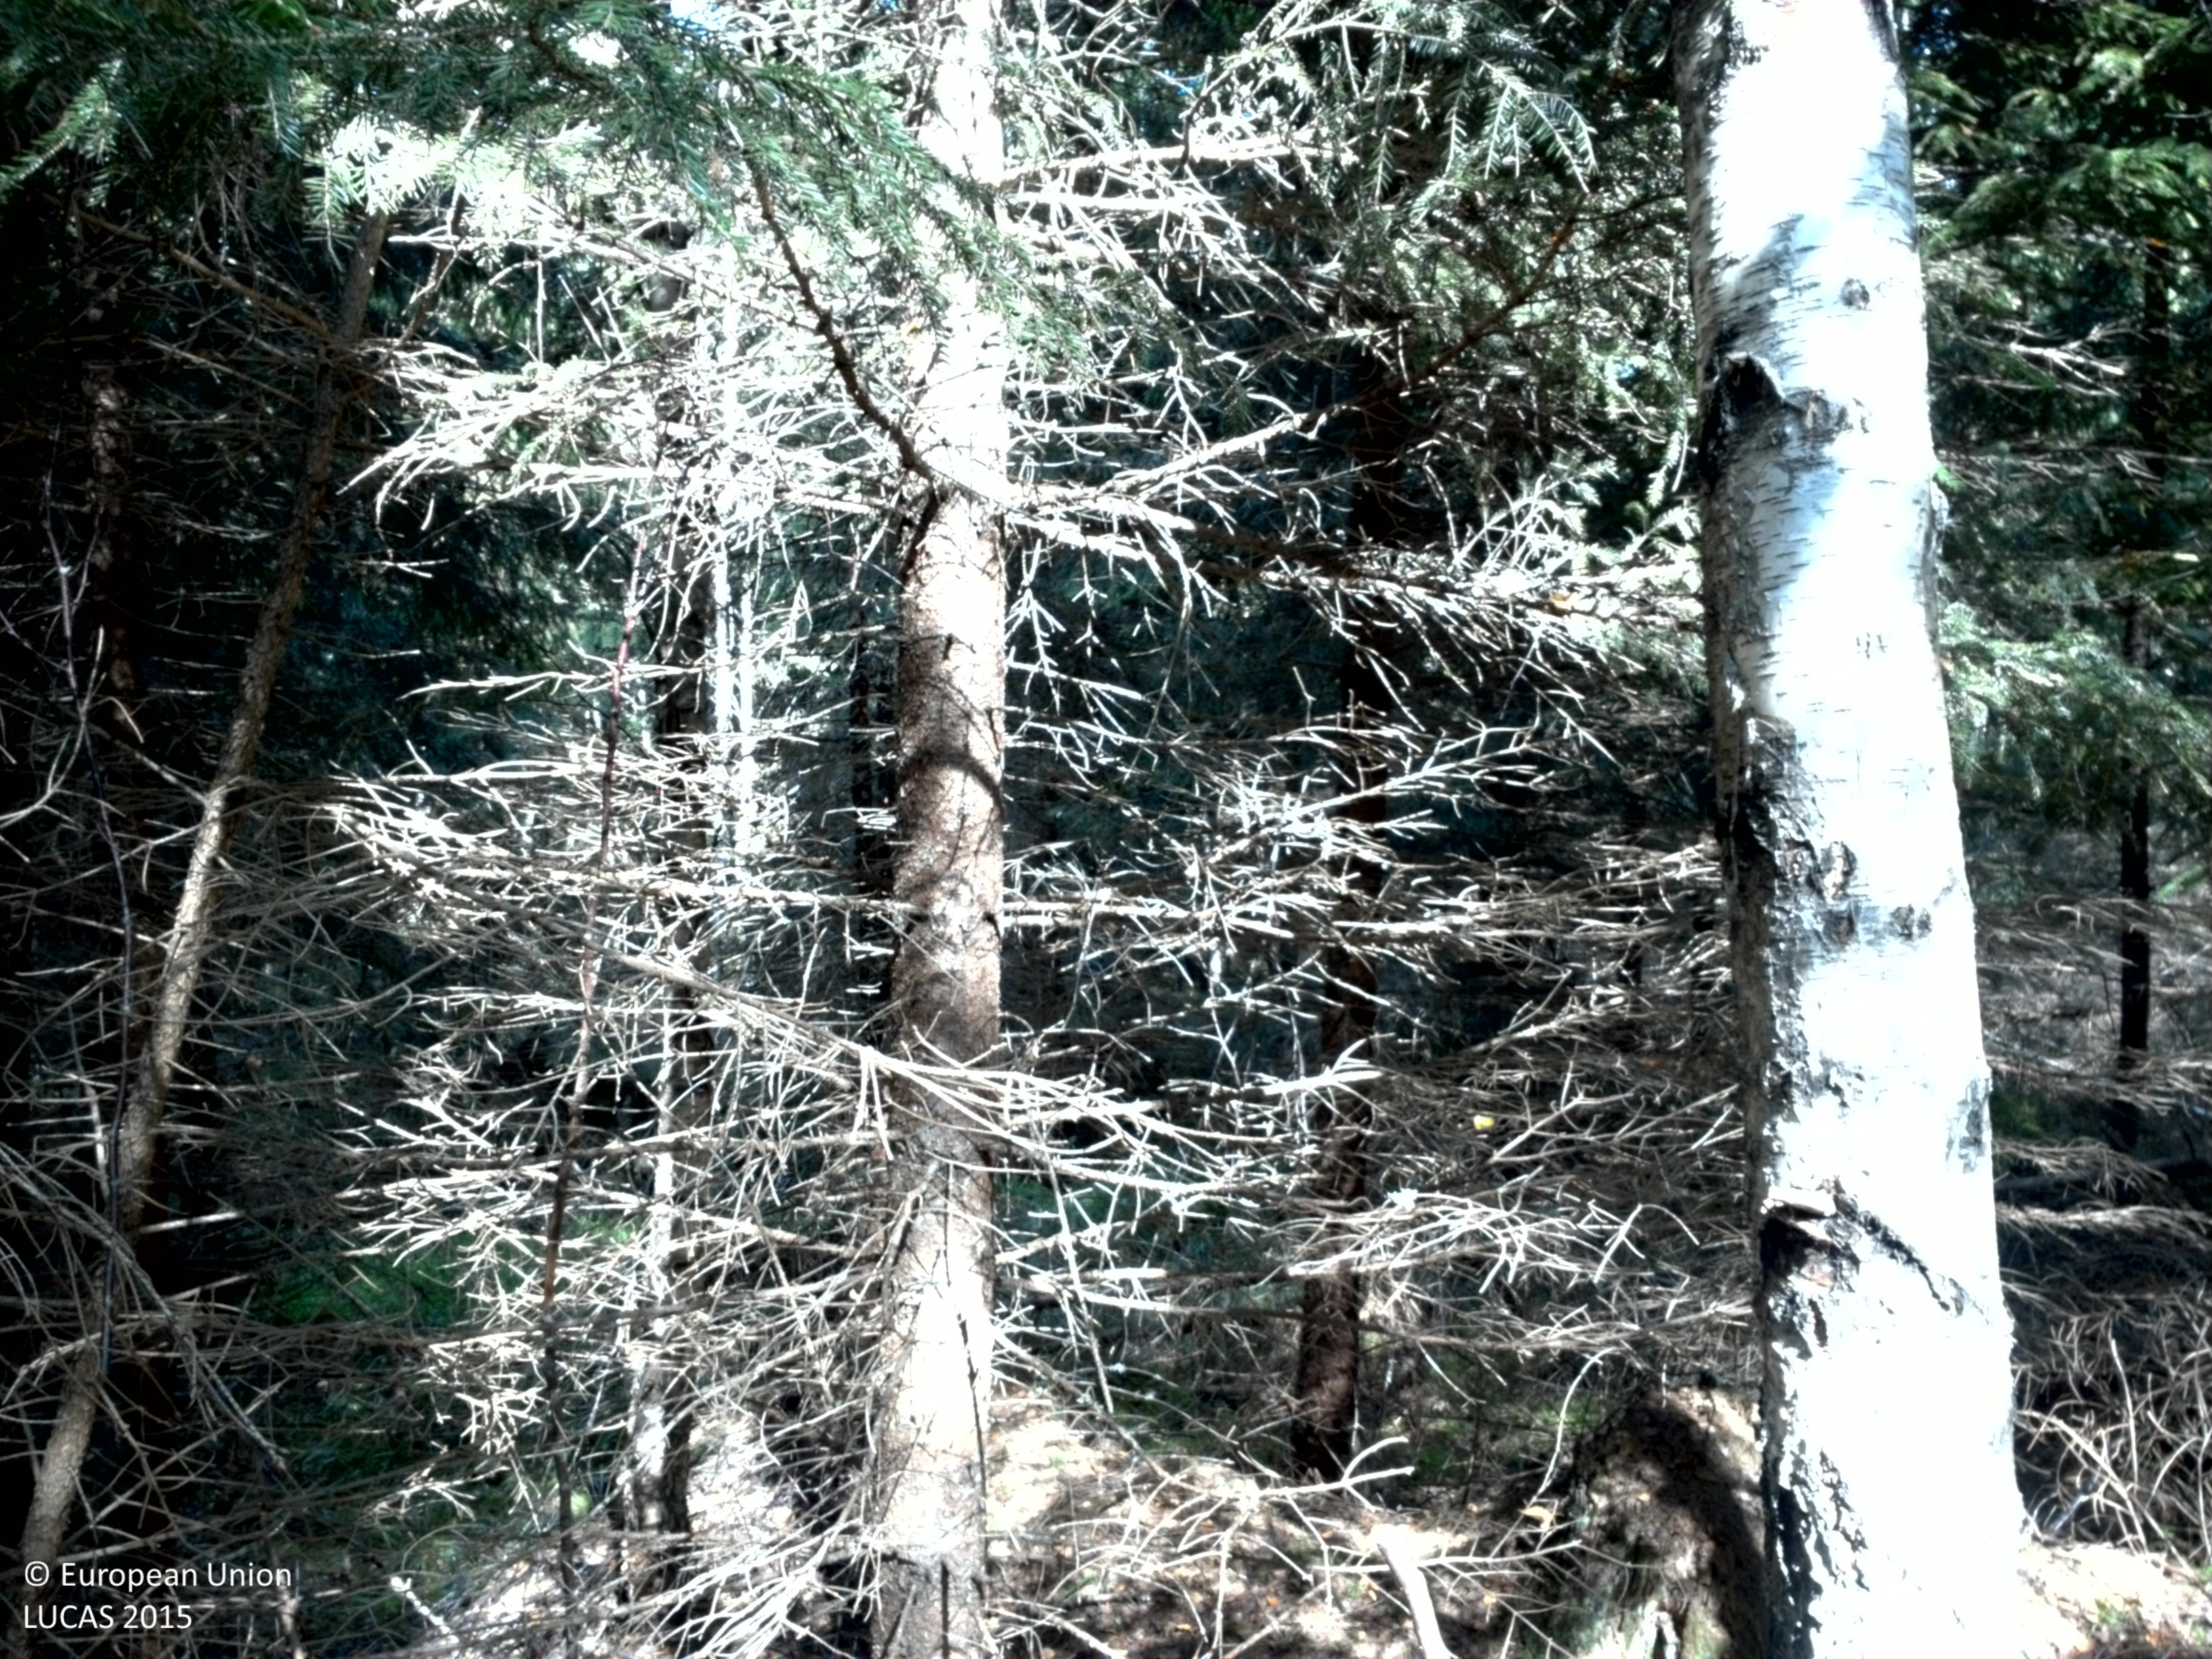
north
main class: Woodland
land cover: Spruce dominated coniferous woodland
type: boreal forest
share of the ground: > 75 %
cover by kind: coniferous forest trees 80 %, broadleaved forest trees 10 %, lichens and mosses 5 %, unconsolidated bare surface 5 %
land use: Forestry
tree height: > 5 m
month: August
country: SE
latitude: 60.0727
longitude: 17.8108
